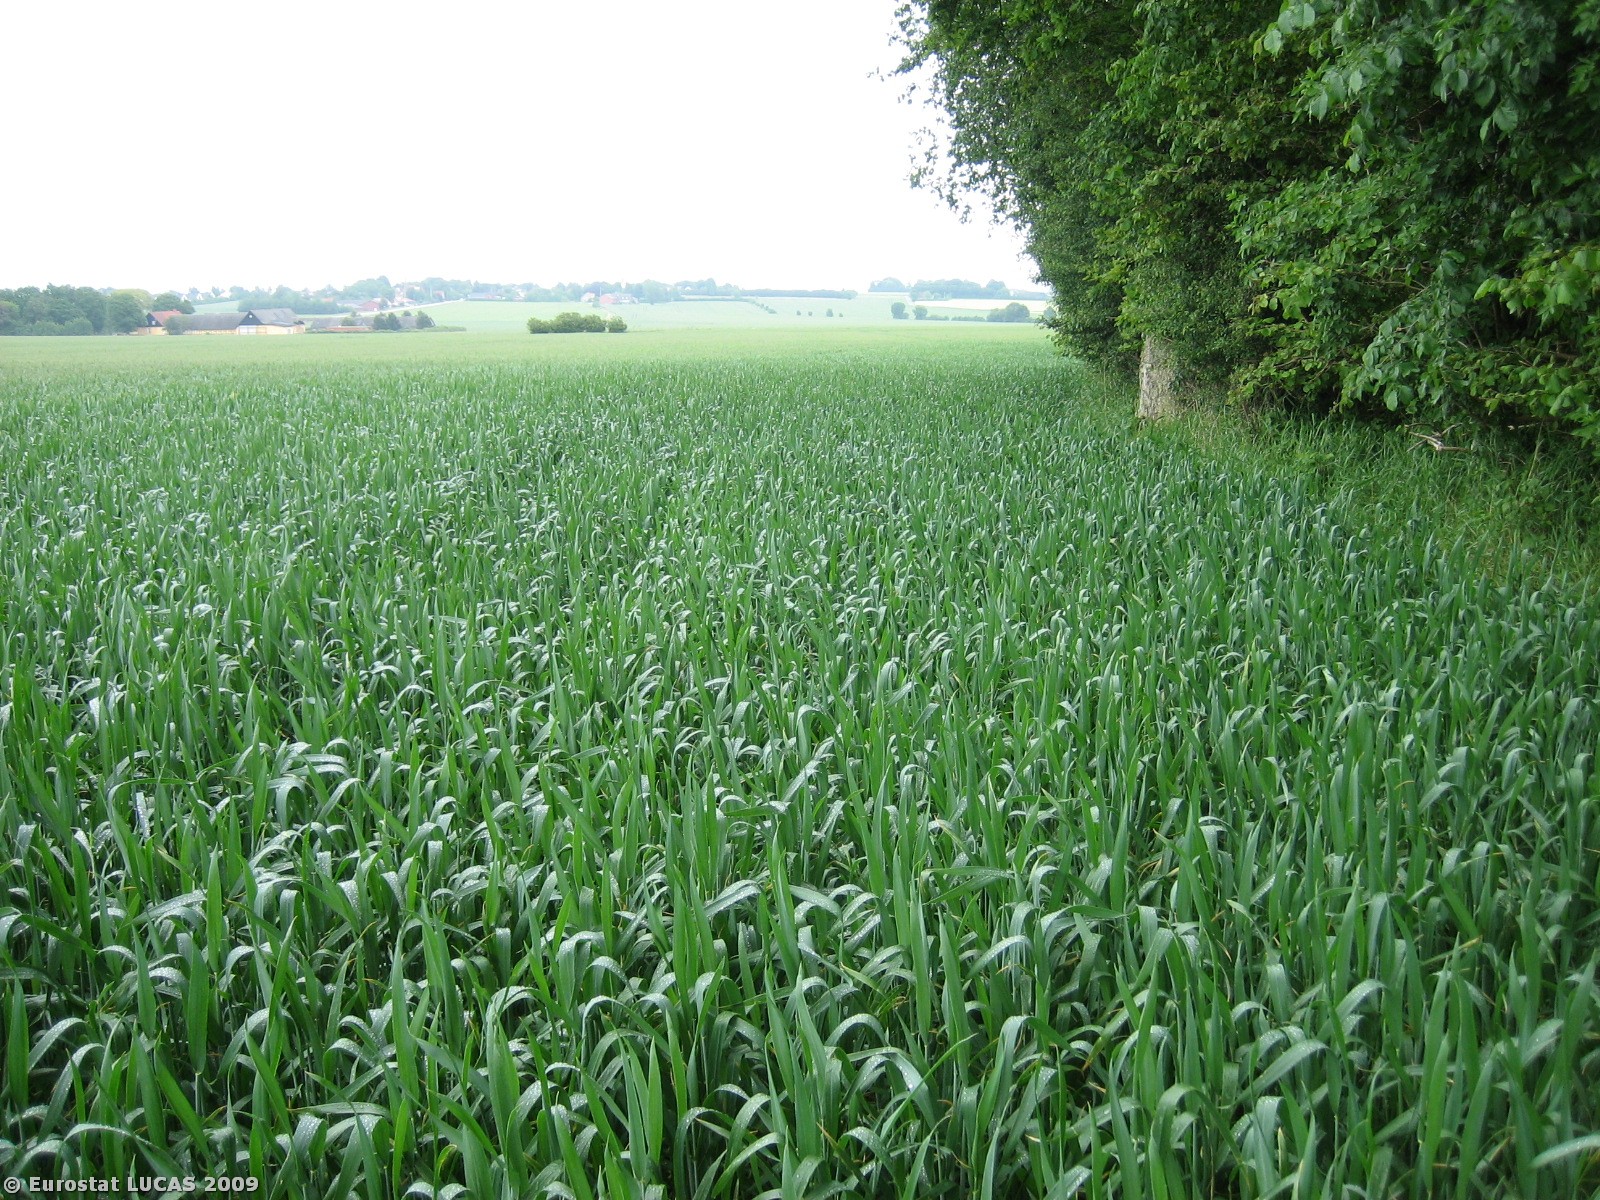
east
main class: Cropland
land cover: Common wheat
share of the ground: > 75 %
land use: Agriculture (excluding fallow land and kitchen gardens)
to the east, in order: Common wheat; Tracks; Grass margins; Common wheat
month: June
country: DK
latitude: 55.9719
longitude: 10.2081
